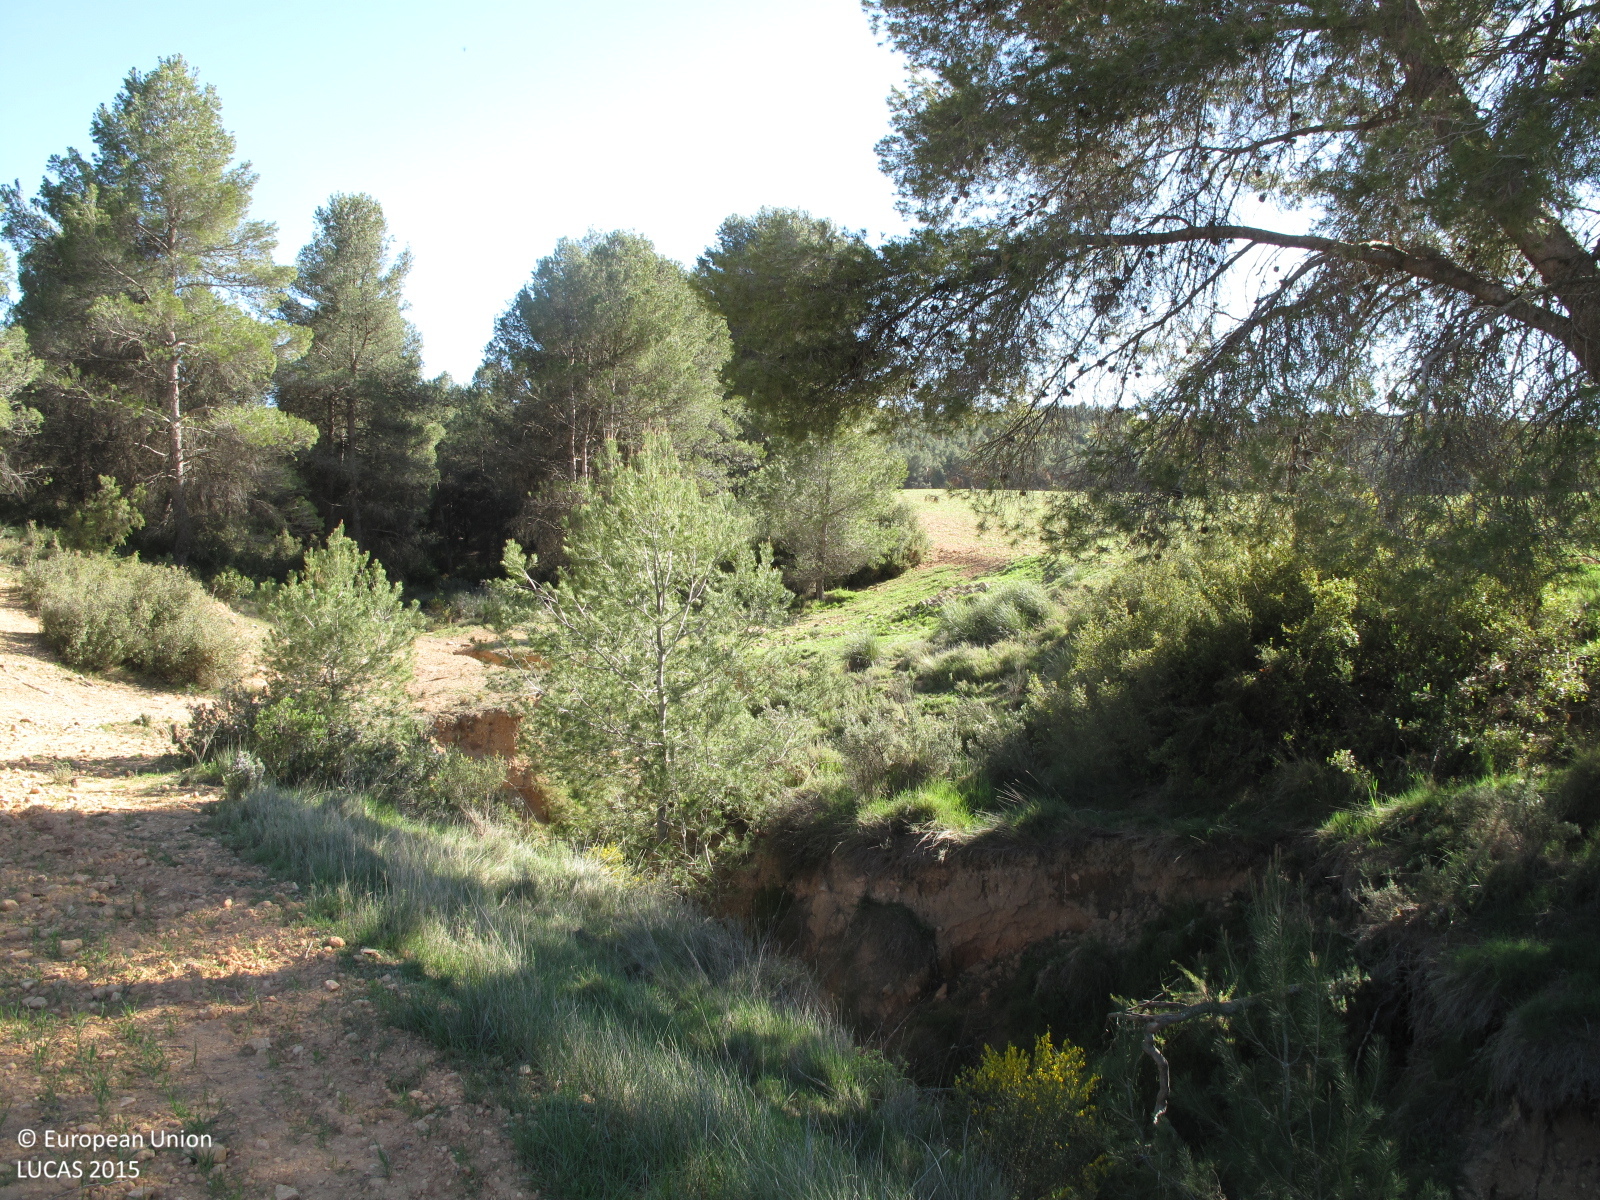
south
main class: Cropland
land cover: Barley
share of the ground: 10 - 25 %
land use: Agriculture (excluding fallow land and kitchen gardens)
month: March
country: ES
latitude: 38.8262
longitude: -0.9933
